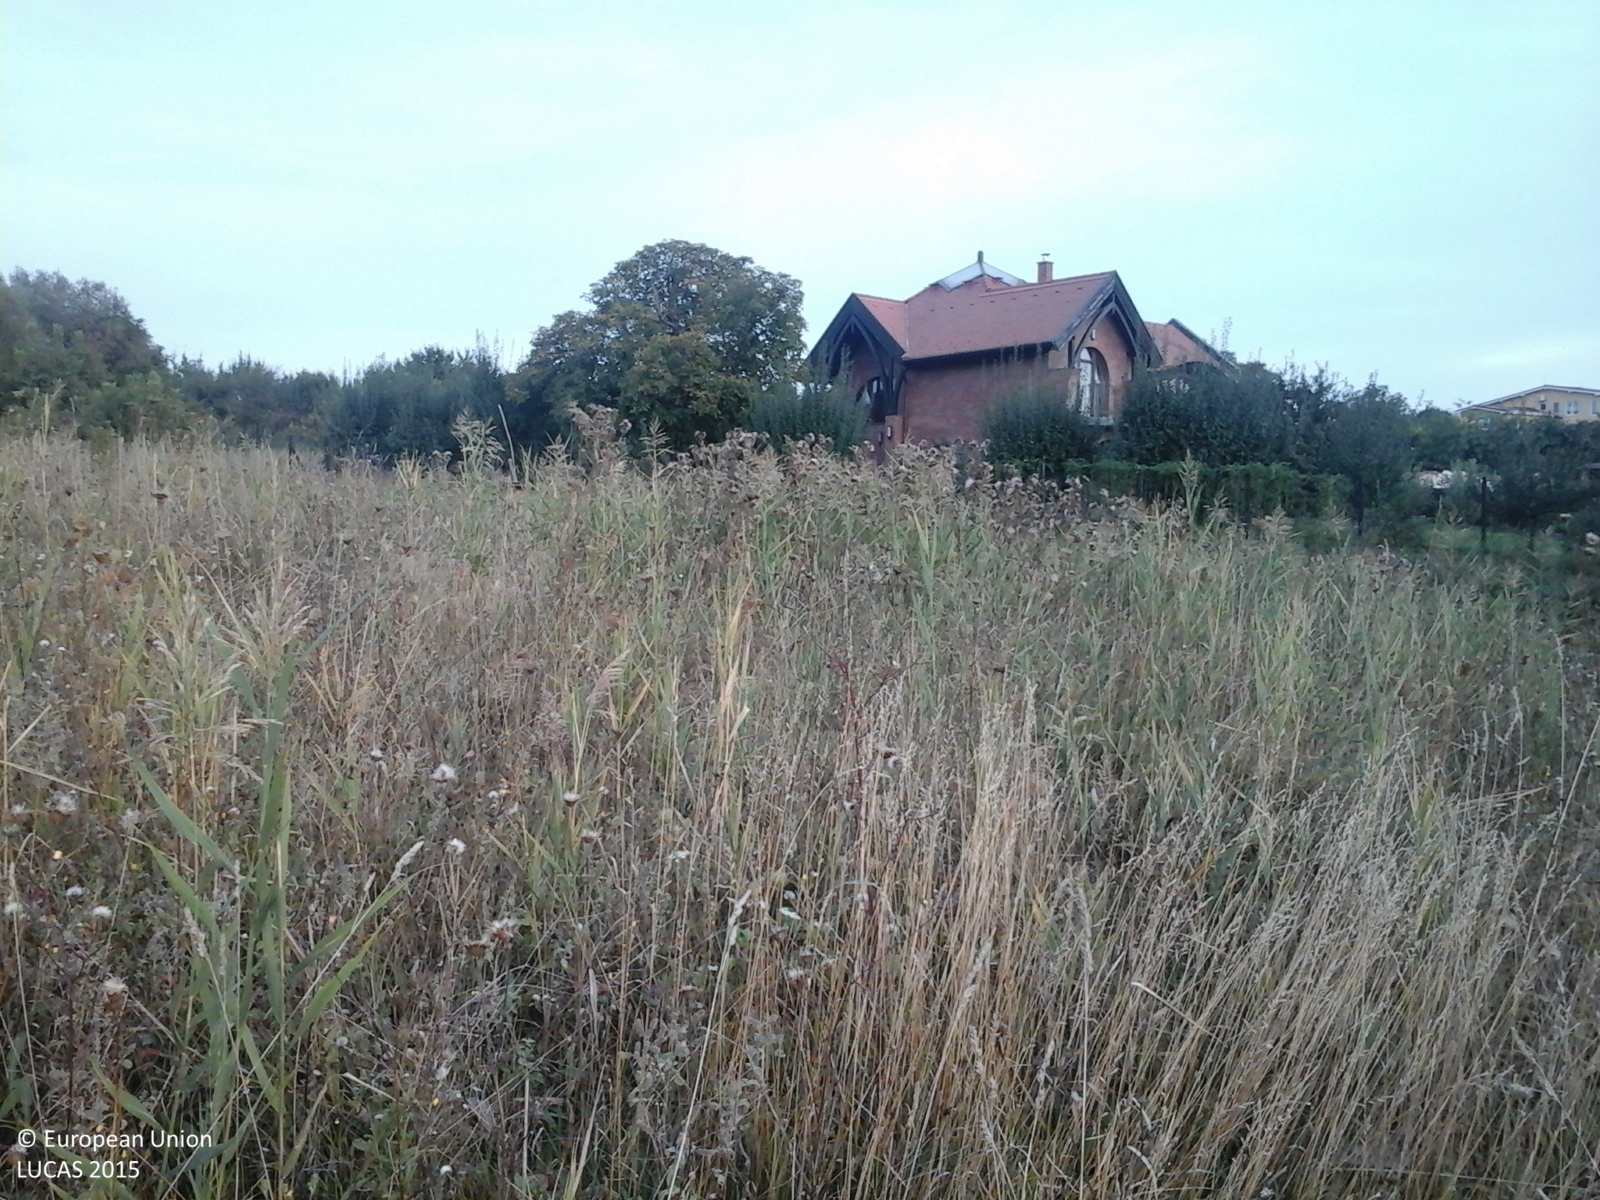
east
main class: Woodland
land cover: Broadleaved woodland
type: non-riverine alder, birch or aspen forest
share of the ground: > 75 %
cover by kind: broadleaved forest trees 100 %
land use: Forestry
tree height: > 5 m
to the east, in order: Broadleaved woodland; Fences; Grassland with sparse tree/shrub cover; Artificial constructions in urban areas; Other fruit trees and berries; Spontaneously vegetated surfaces; Broadleaved woodland; Spontaneously vegetated surfaces; Grassland with sparse tree/shrub cover; Abandoned hedges; Fences; Spontaneously vegetated surfaces
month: September
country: RO
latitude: 46.7495
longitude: 23.6464
